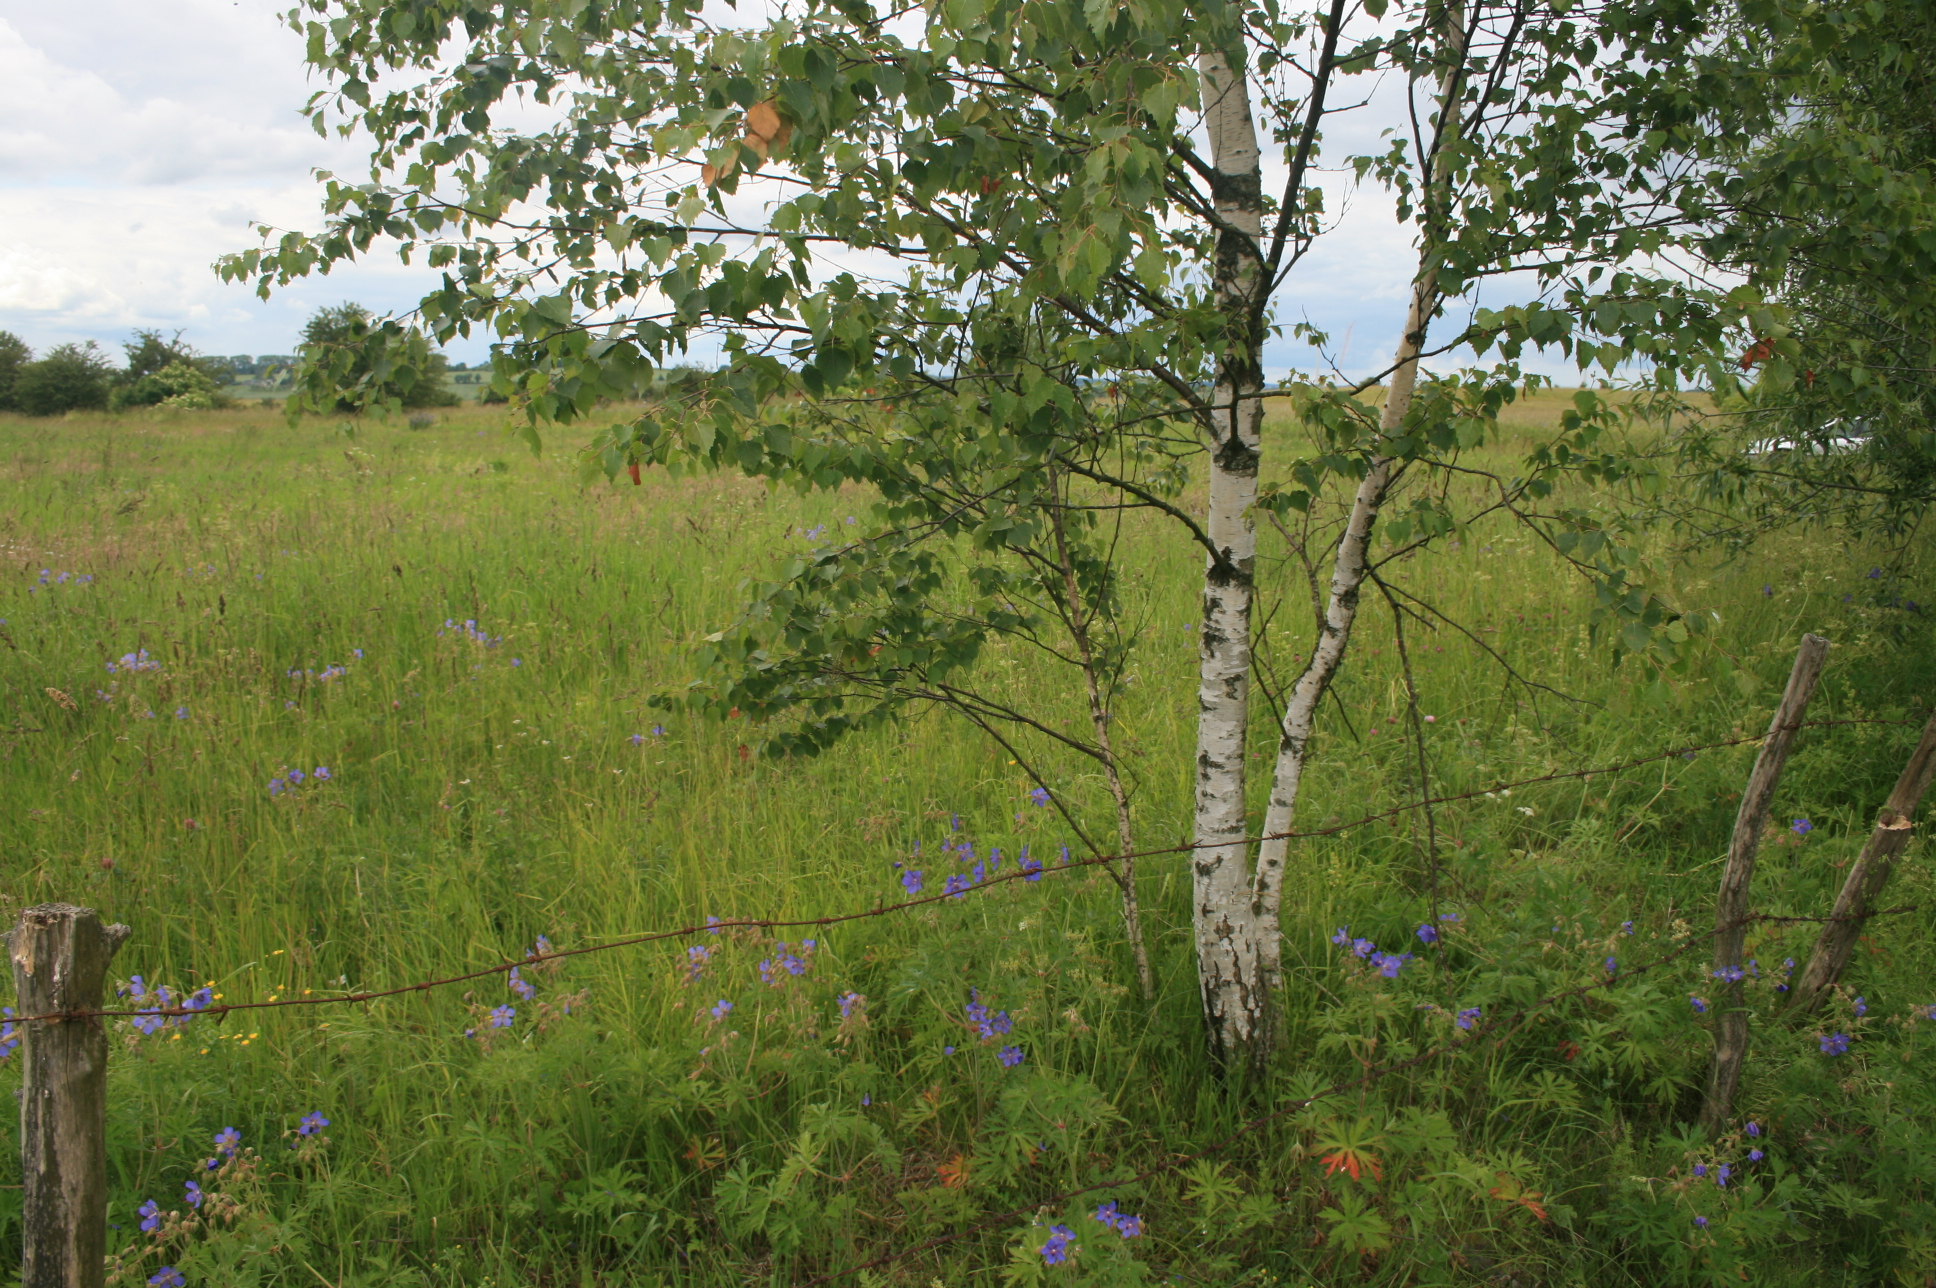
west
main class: Grassland
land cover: Spontaneously vegetated surfaces
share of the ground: > 75 %
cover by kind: herbaceous plants 100 %
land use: Agriculture (excluding fallow land and kitchen gardens)
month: June
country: LT
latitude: 55.1612
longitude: 22.0626
